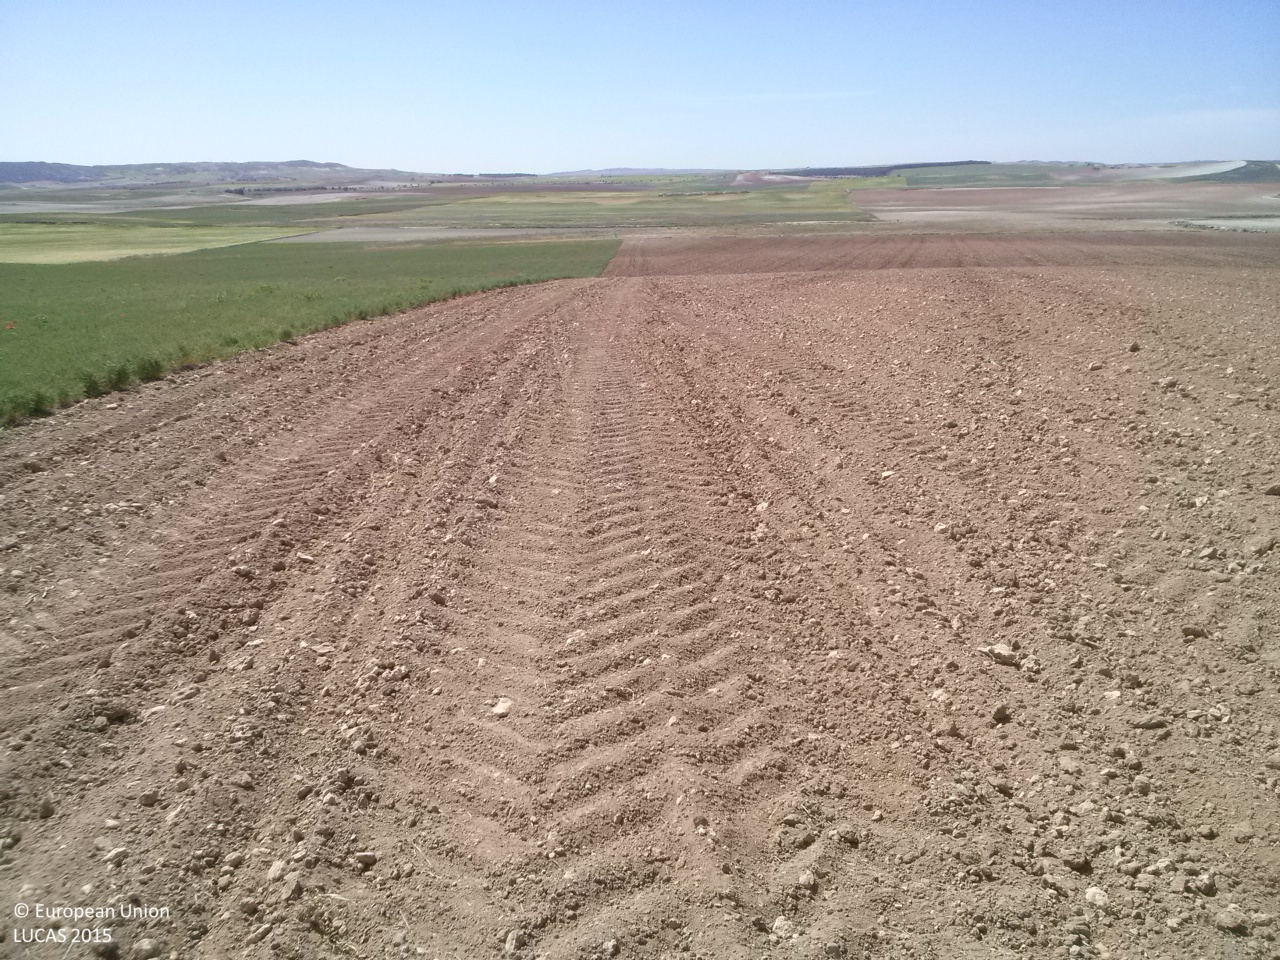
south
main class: Cropland
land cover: Sunflower
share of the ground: < 10 %
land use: Agriculture (excluding fallow land and kitchen gardens)
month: May
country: ES
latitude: 39.9450
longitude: -2.7423
